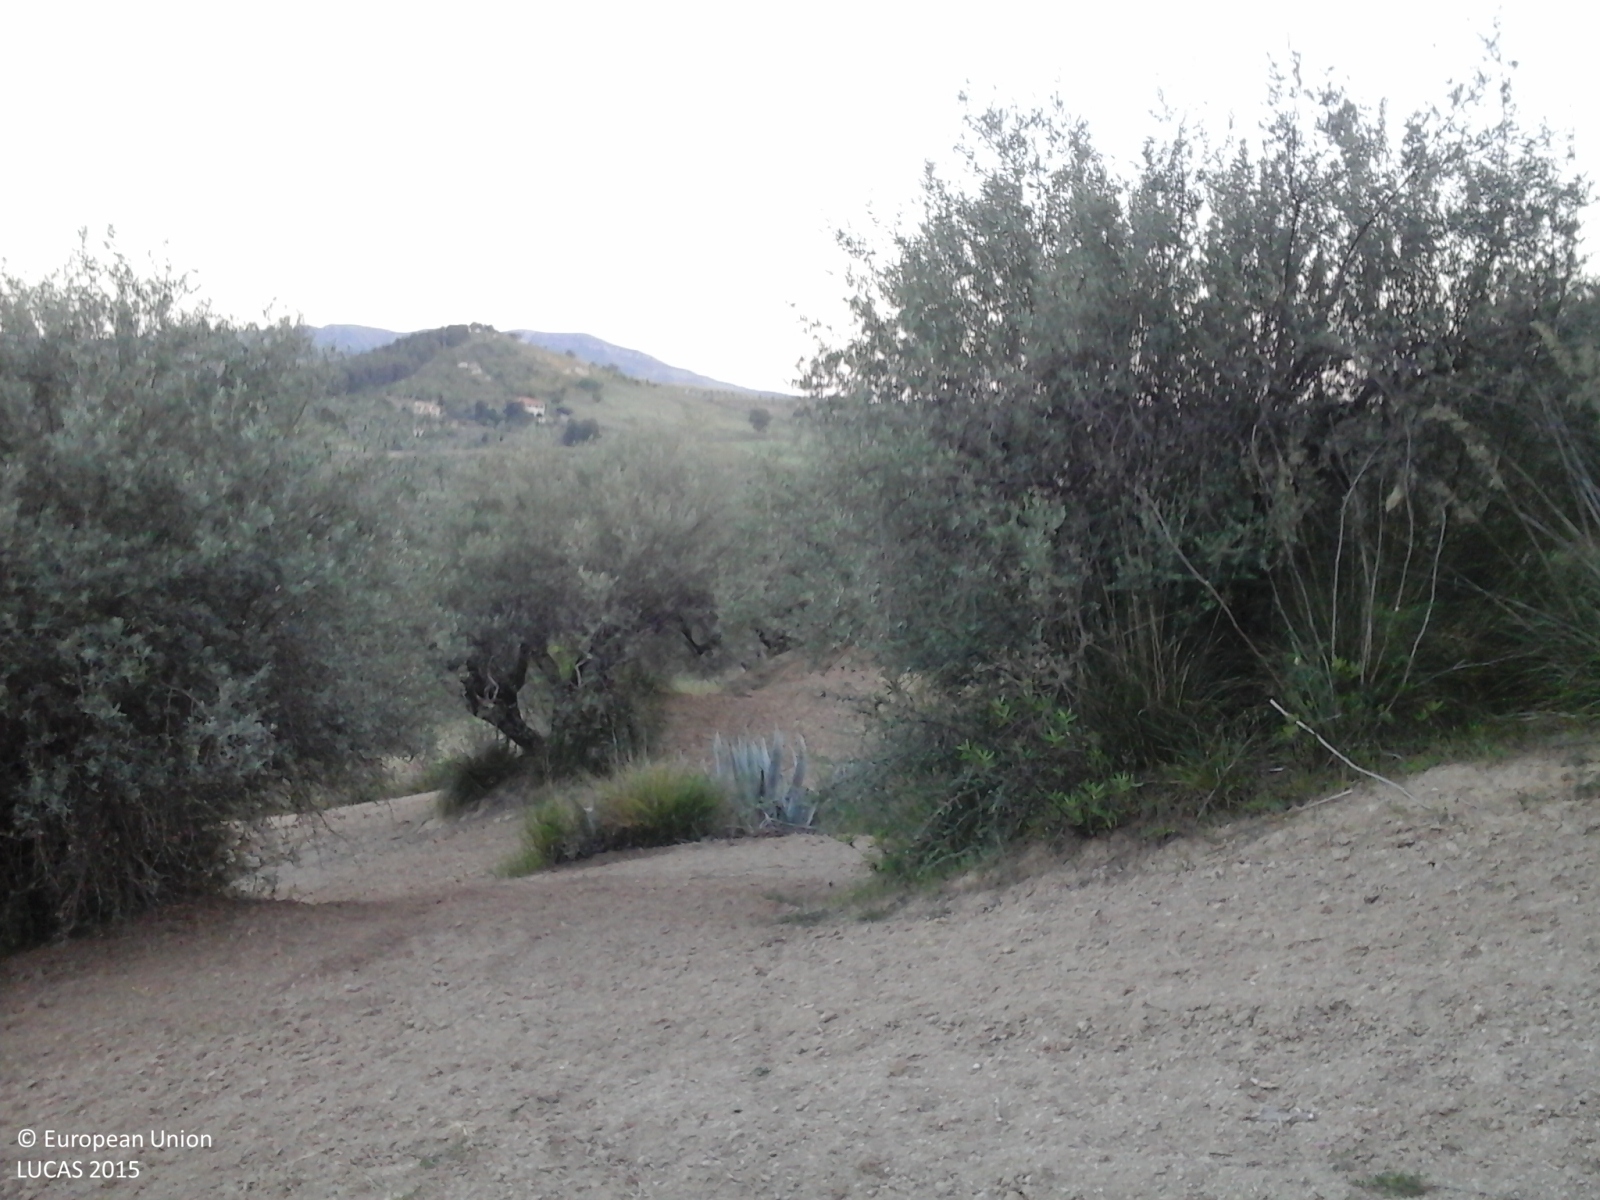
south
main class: Grassland
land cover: Grassland with sparse tree/shrub cover
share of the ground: 50 - 75 %
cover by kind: herbaceous plants 85 %, shrubs 10 %, broadleaved forest trees 5 %
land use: Agriculture (excluding fallow land and kitchen gardens)
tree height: < 5 m
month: May
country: IT
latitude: 37.5824
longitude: 14.1930
